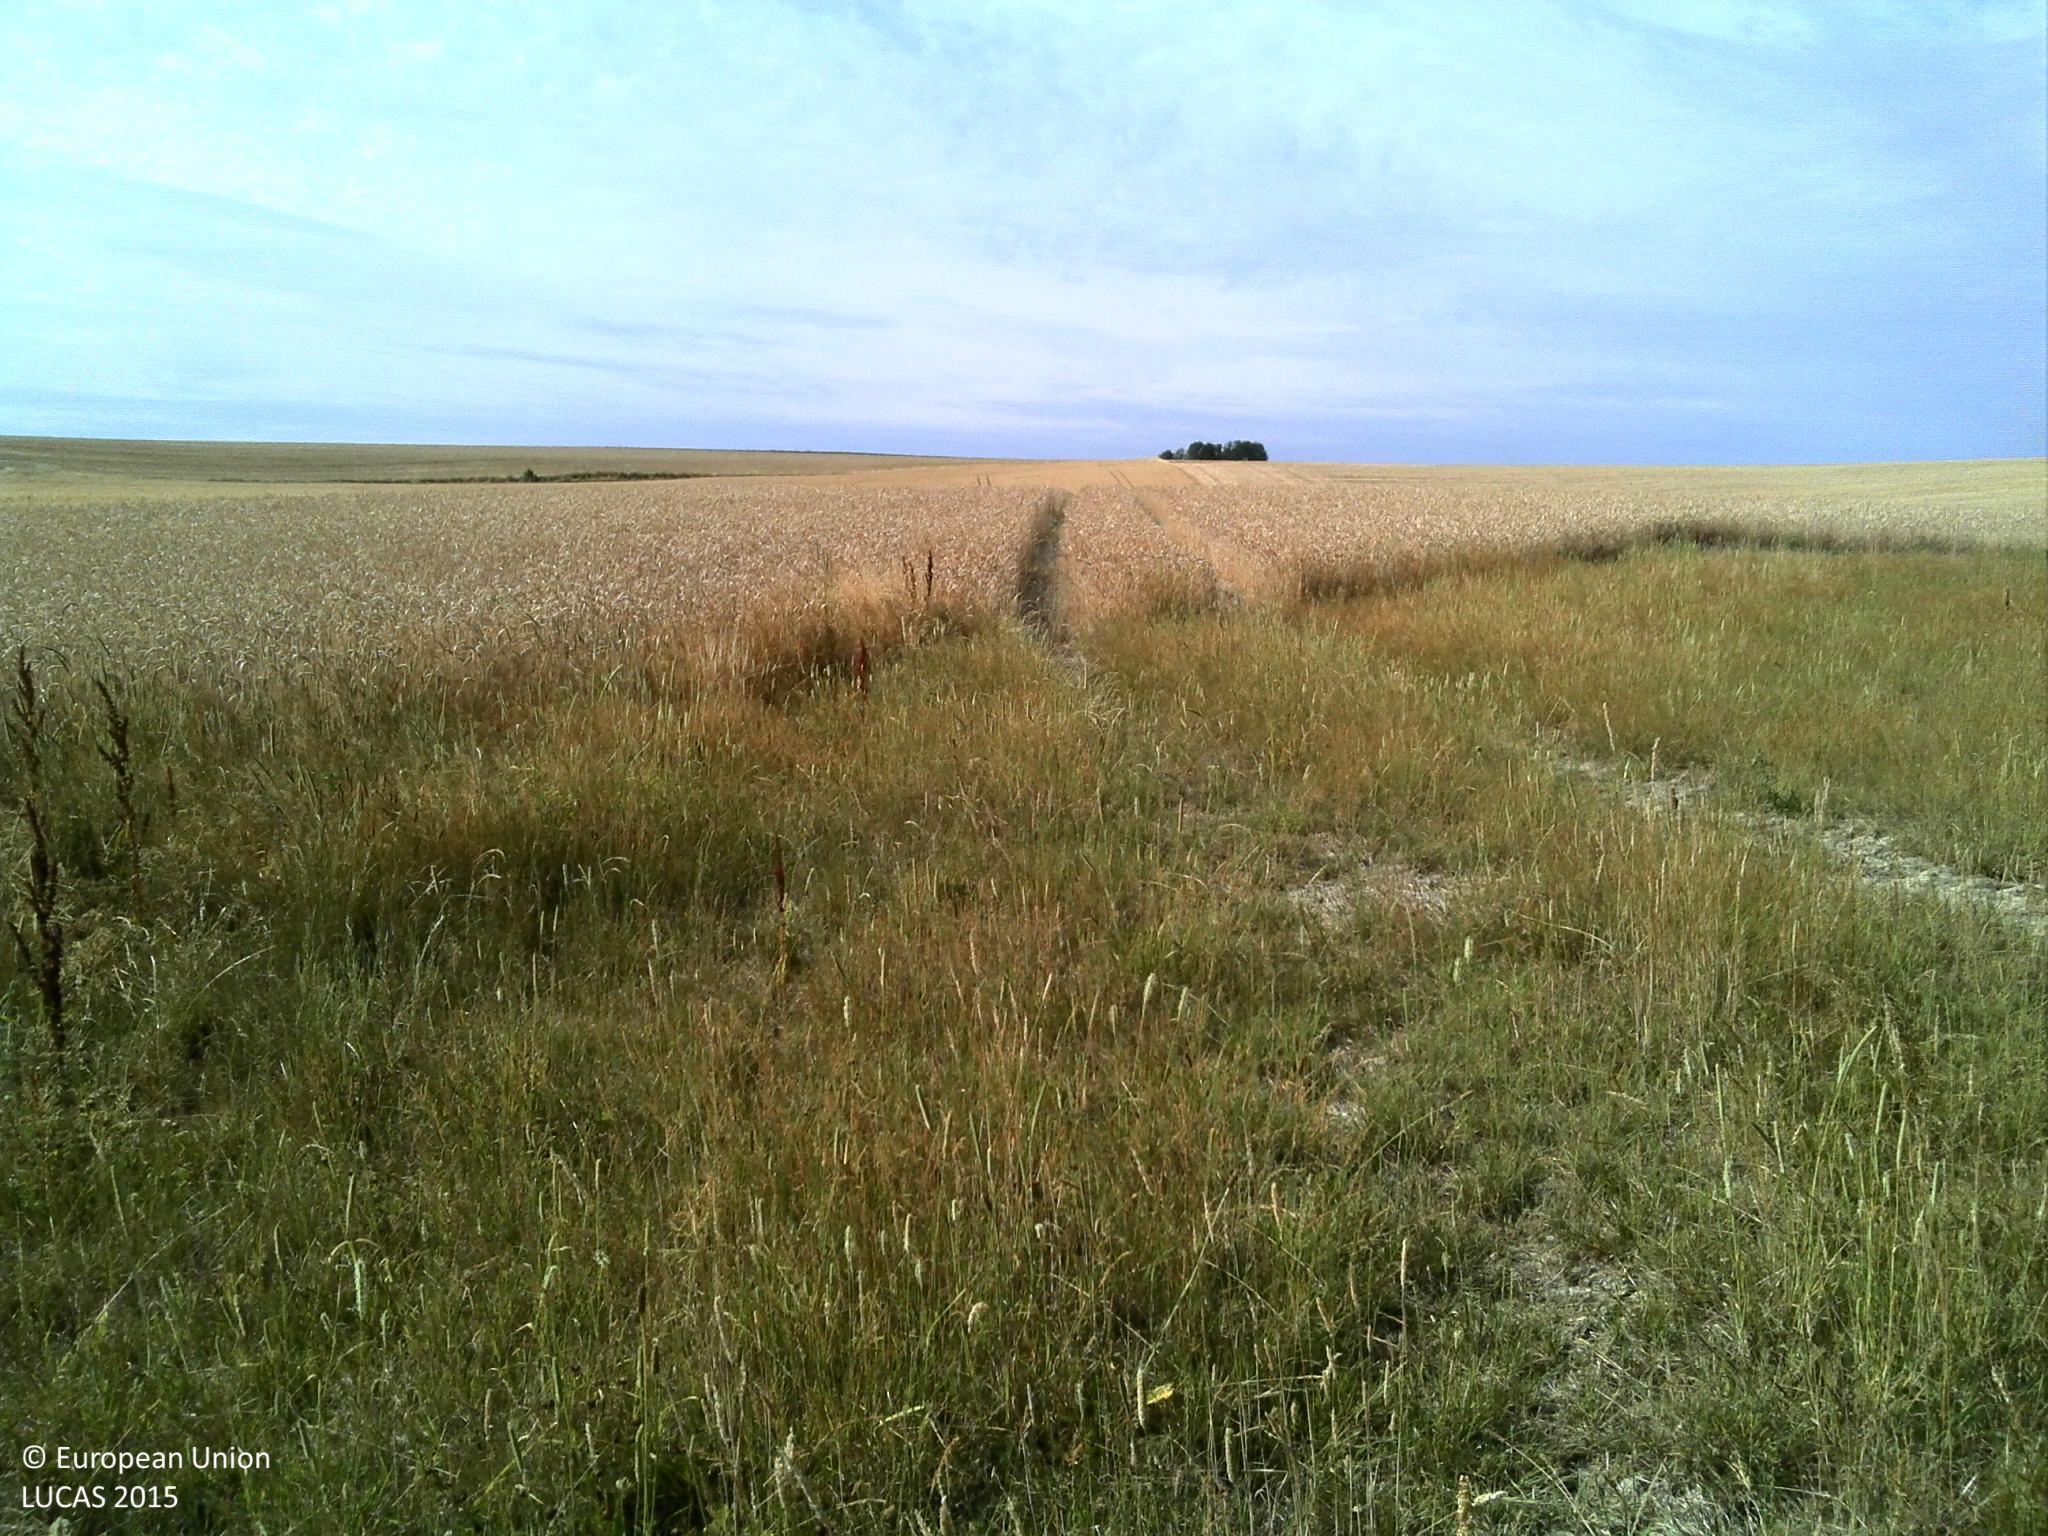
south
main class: Grassland
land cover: Grassland without tree/shrub cover
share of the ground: > 75 %
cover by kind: herbaceous plants 100 %
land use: Agriculture (excluding fallow land and kitchen gardens)
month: July
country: FR
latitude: 48.9146
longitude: 4.8533
